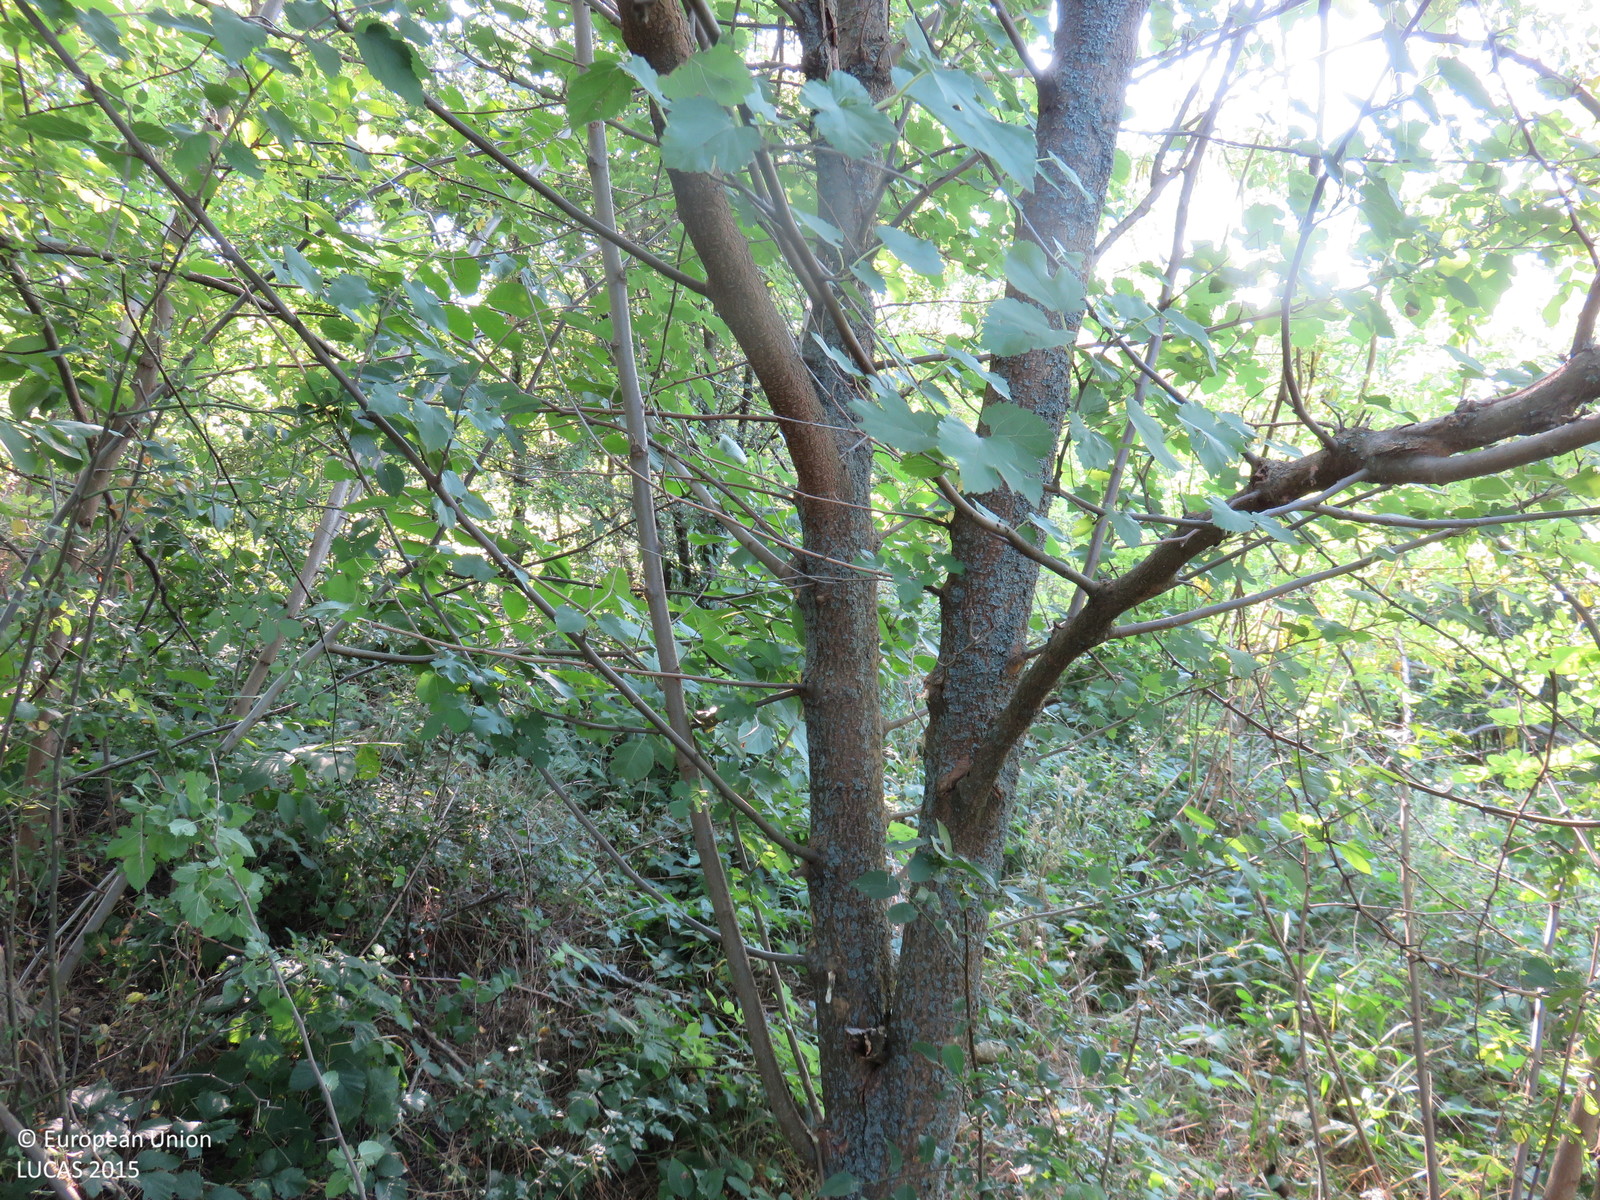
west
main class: Woodland
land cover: Broadleaved woodland
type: mesophytic deciduous forest
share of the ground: > 75 %
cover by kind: broadleaved forest trees 90 %, shrubs 5 %, herbaceous plants 5 %
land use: Forestry
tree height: < 5 m
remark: Clear cut
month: July
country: BG
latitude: 43.4880
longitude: 25.0208
